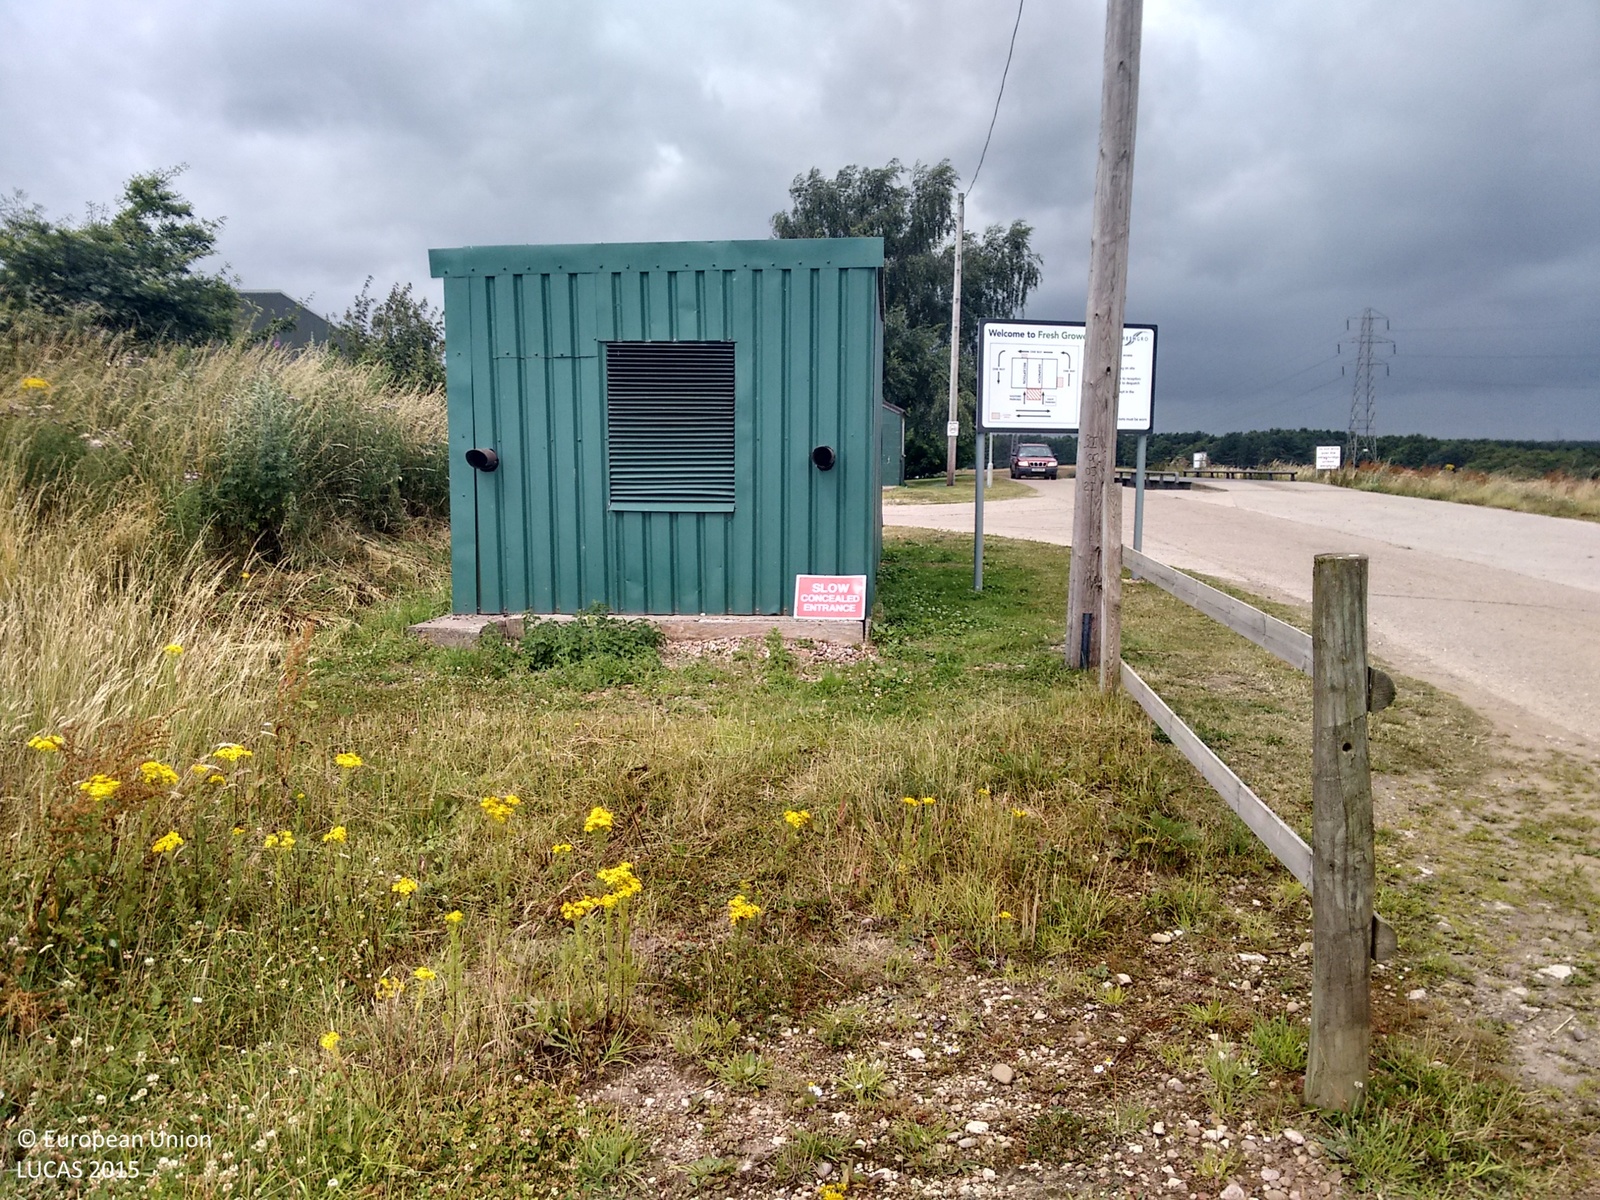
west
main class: Grassland
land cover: Spontaneously vegetated surfaces
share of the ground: > 75 %
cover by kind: herbaceous plants 100 %
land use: Agriculture (excluding fallow land and kitchen gardens)
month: July
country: GB
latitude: 53.1296
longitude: -1.0593
